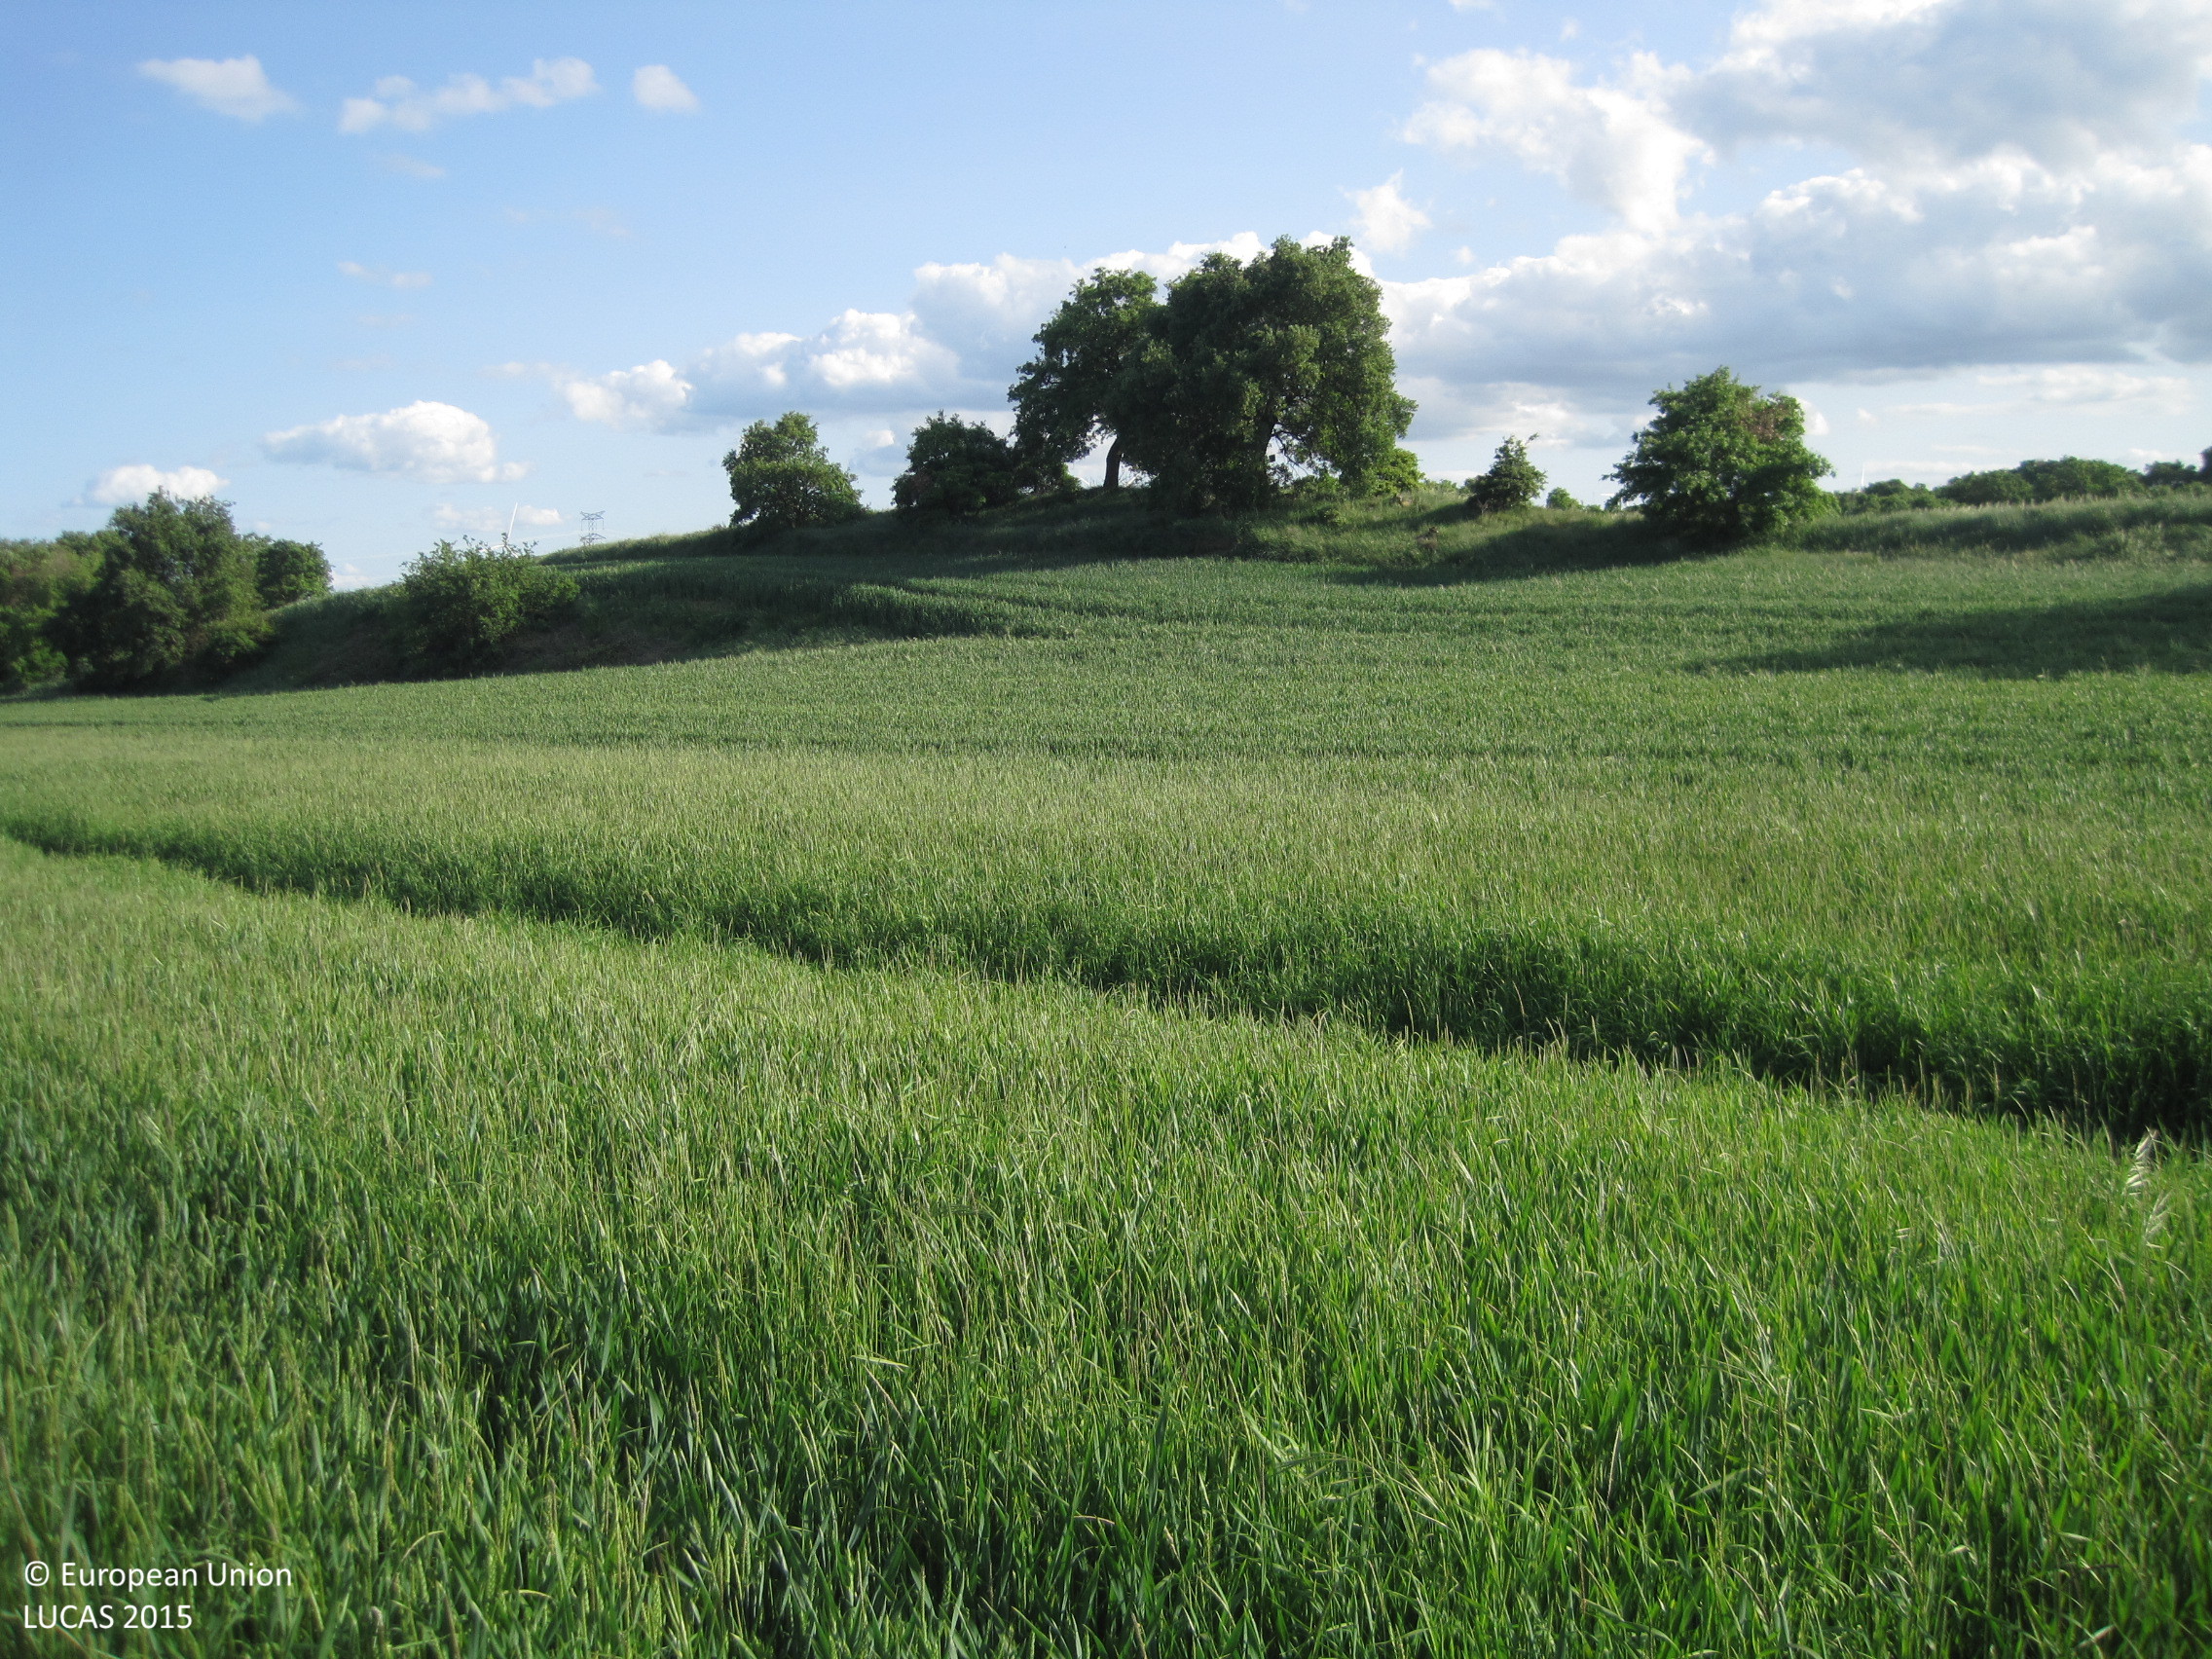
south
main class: Cropland
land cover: Common wheat
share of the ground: > 75 %
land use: Agriculture (excluding fallow land and kitchen gardens)
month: May
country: ES
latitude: 42.6316
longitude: -1.6833
